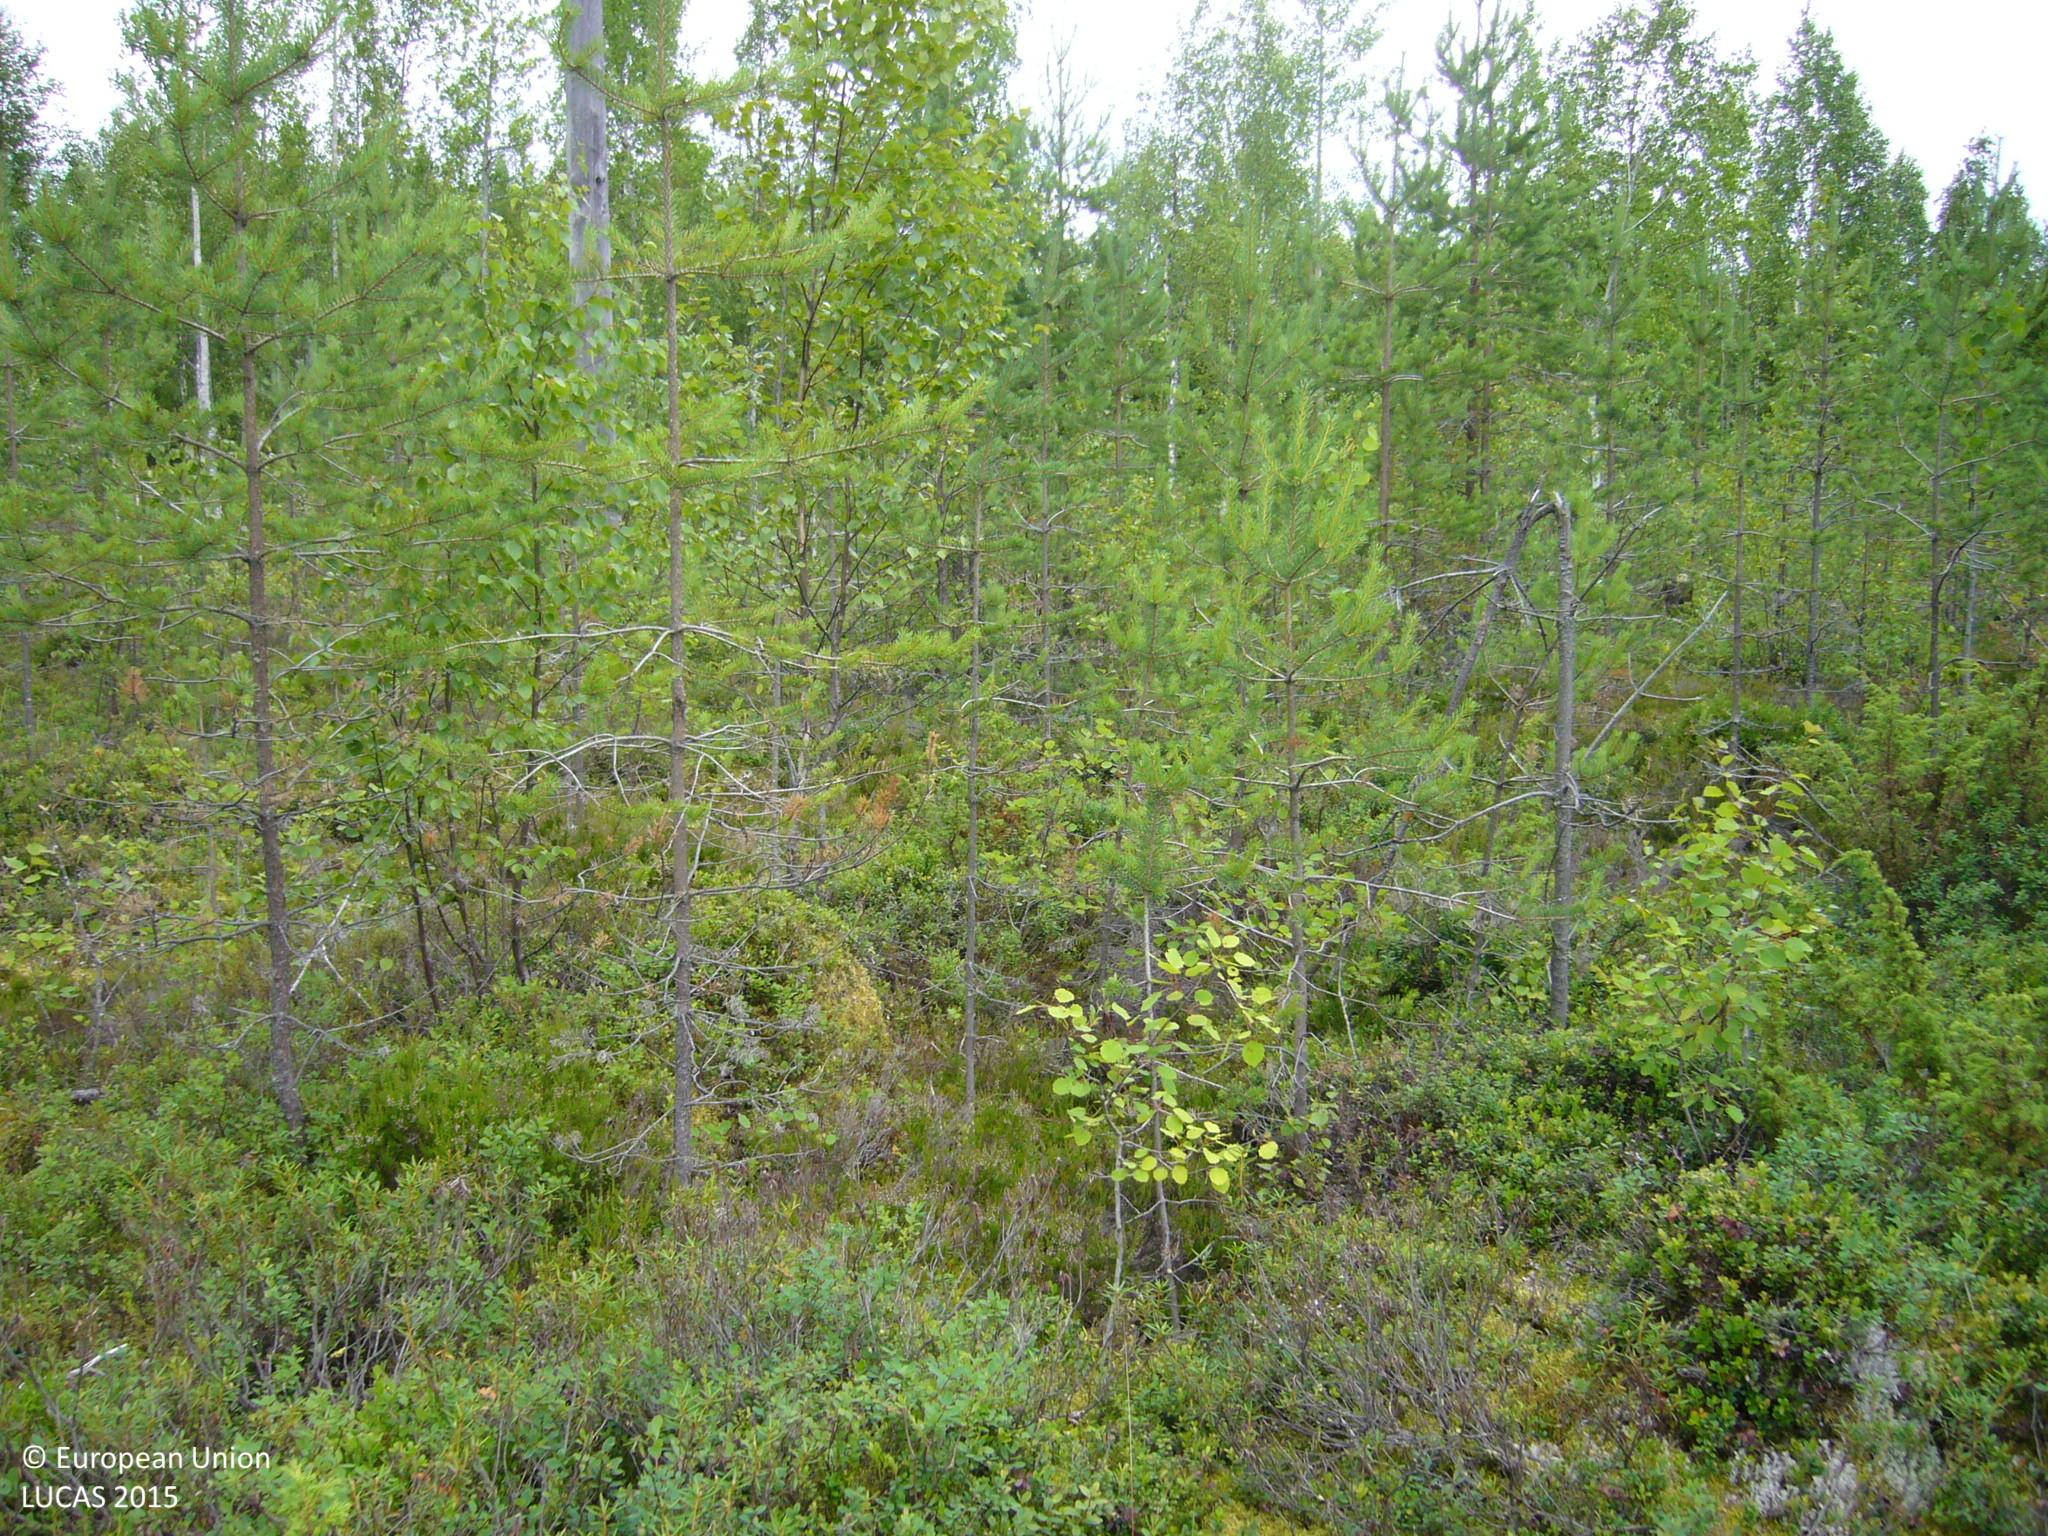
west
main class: Woodland
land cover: Pine dominated mixed woodland
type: boreal forest
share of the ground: 50 - 75 %
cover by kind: coniferous forest trees 40 %, broadleaved forest trees 30 %, shrubs 30 %
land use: Forestry
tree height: < 5 m
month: July
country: FI
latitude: 63.9755
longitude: 26.2736
